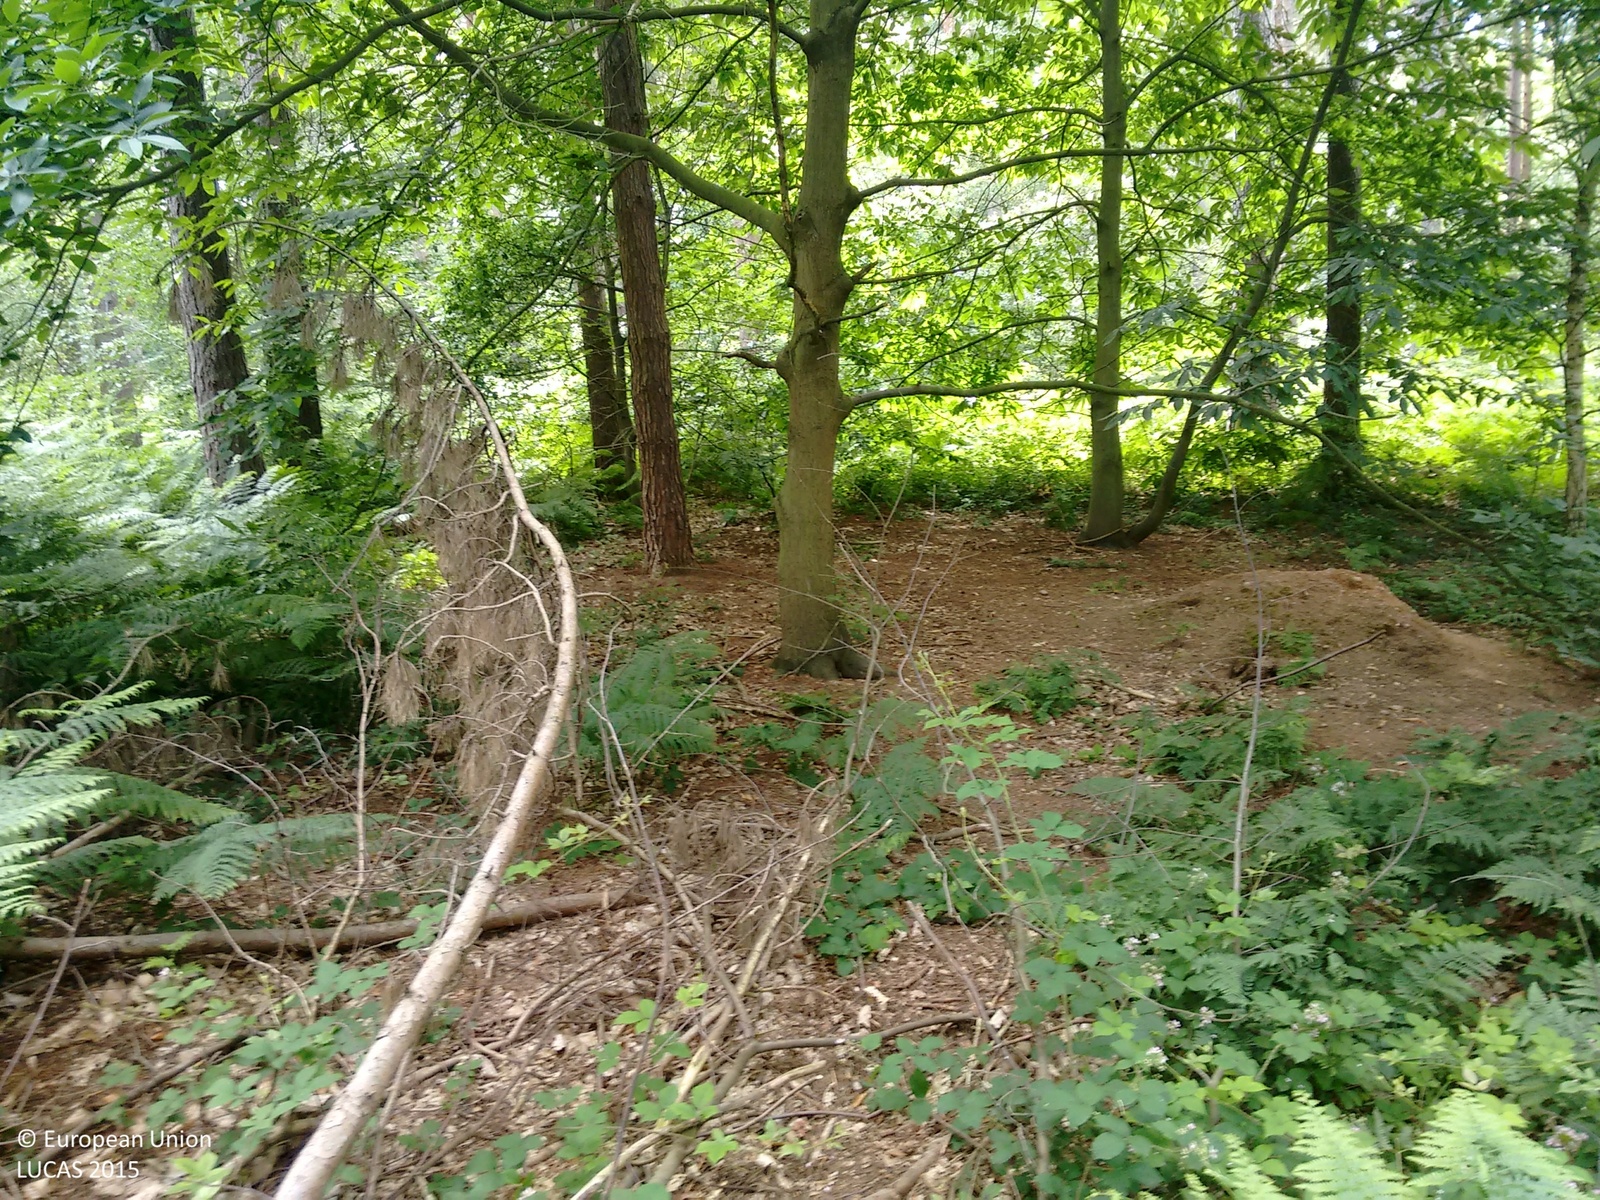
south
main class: Woodland
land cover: Pine dominated coniferous woodland
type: exotic forest
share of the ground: > 75 %
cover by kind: coniferous forest trees 90 %, broadleaved forest trees 10 %
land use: Forestry
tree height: > 5 m
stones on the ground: < 10 %
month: July
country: GB
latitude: 53.2947
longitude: -1.0413
